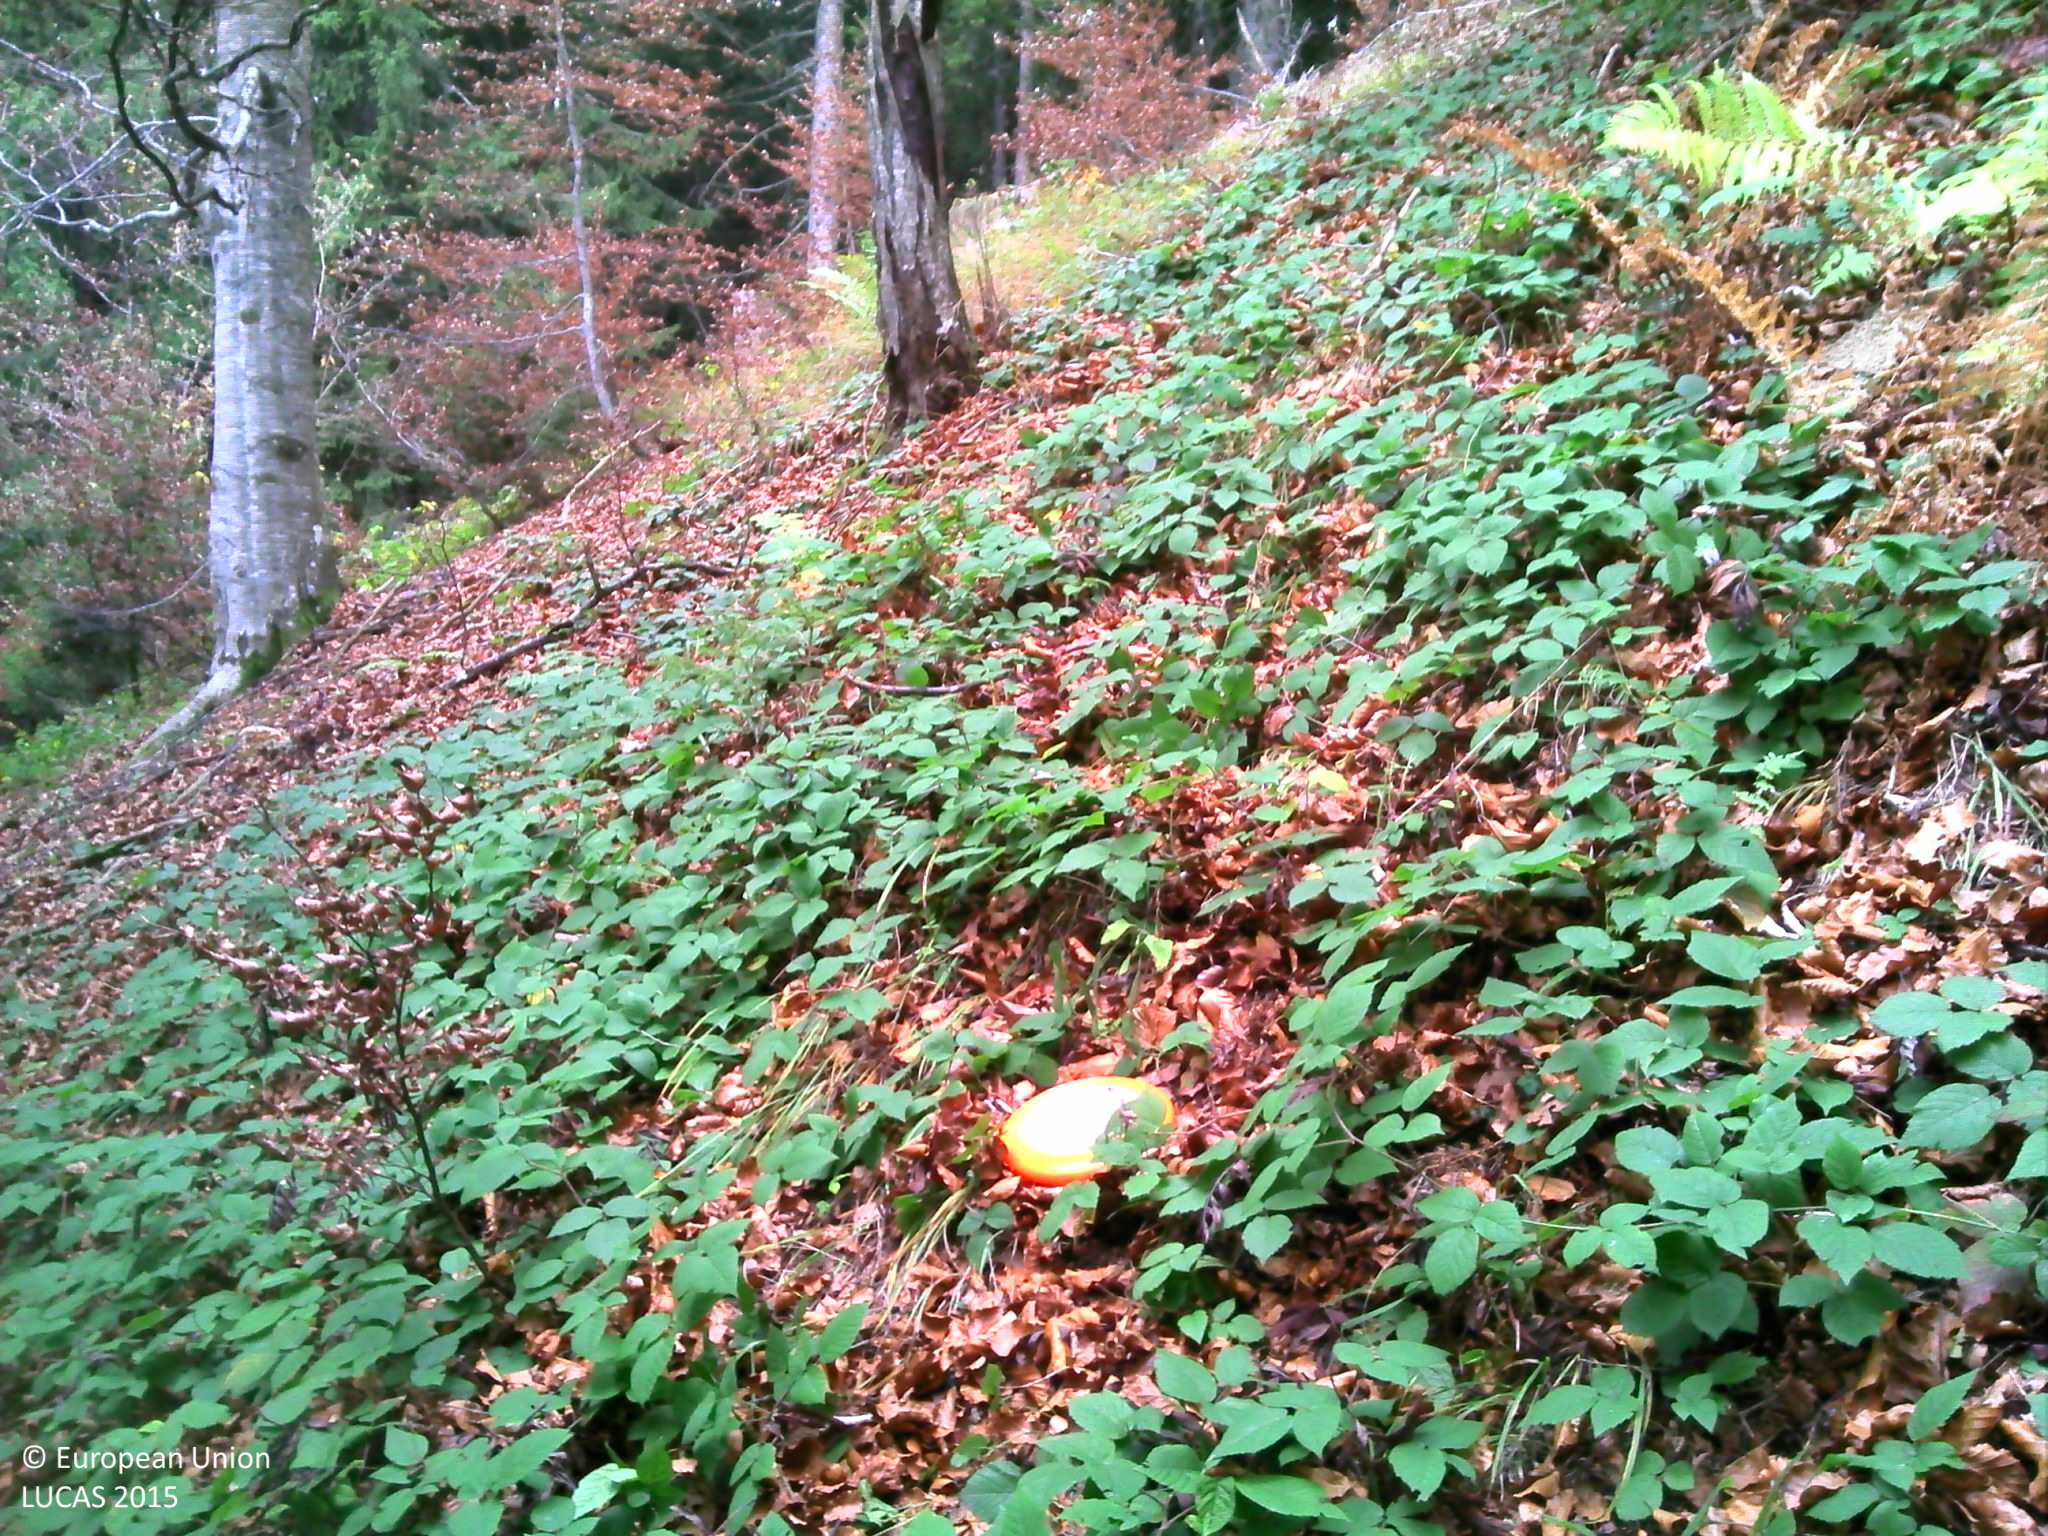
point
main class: Woodland
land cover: Spruce dominated mixed woodland
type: mountainous beech forest
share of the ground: > 75 %
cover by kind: coniferous forest trees 60 %, broadleaved forest trees 30 %, herbaceous plants 10 %
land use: Forestry
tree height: > 5 m
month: November
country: FR
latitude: 45.7880
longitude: 6.4667
